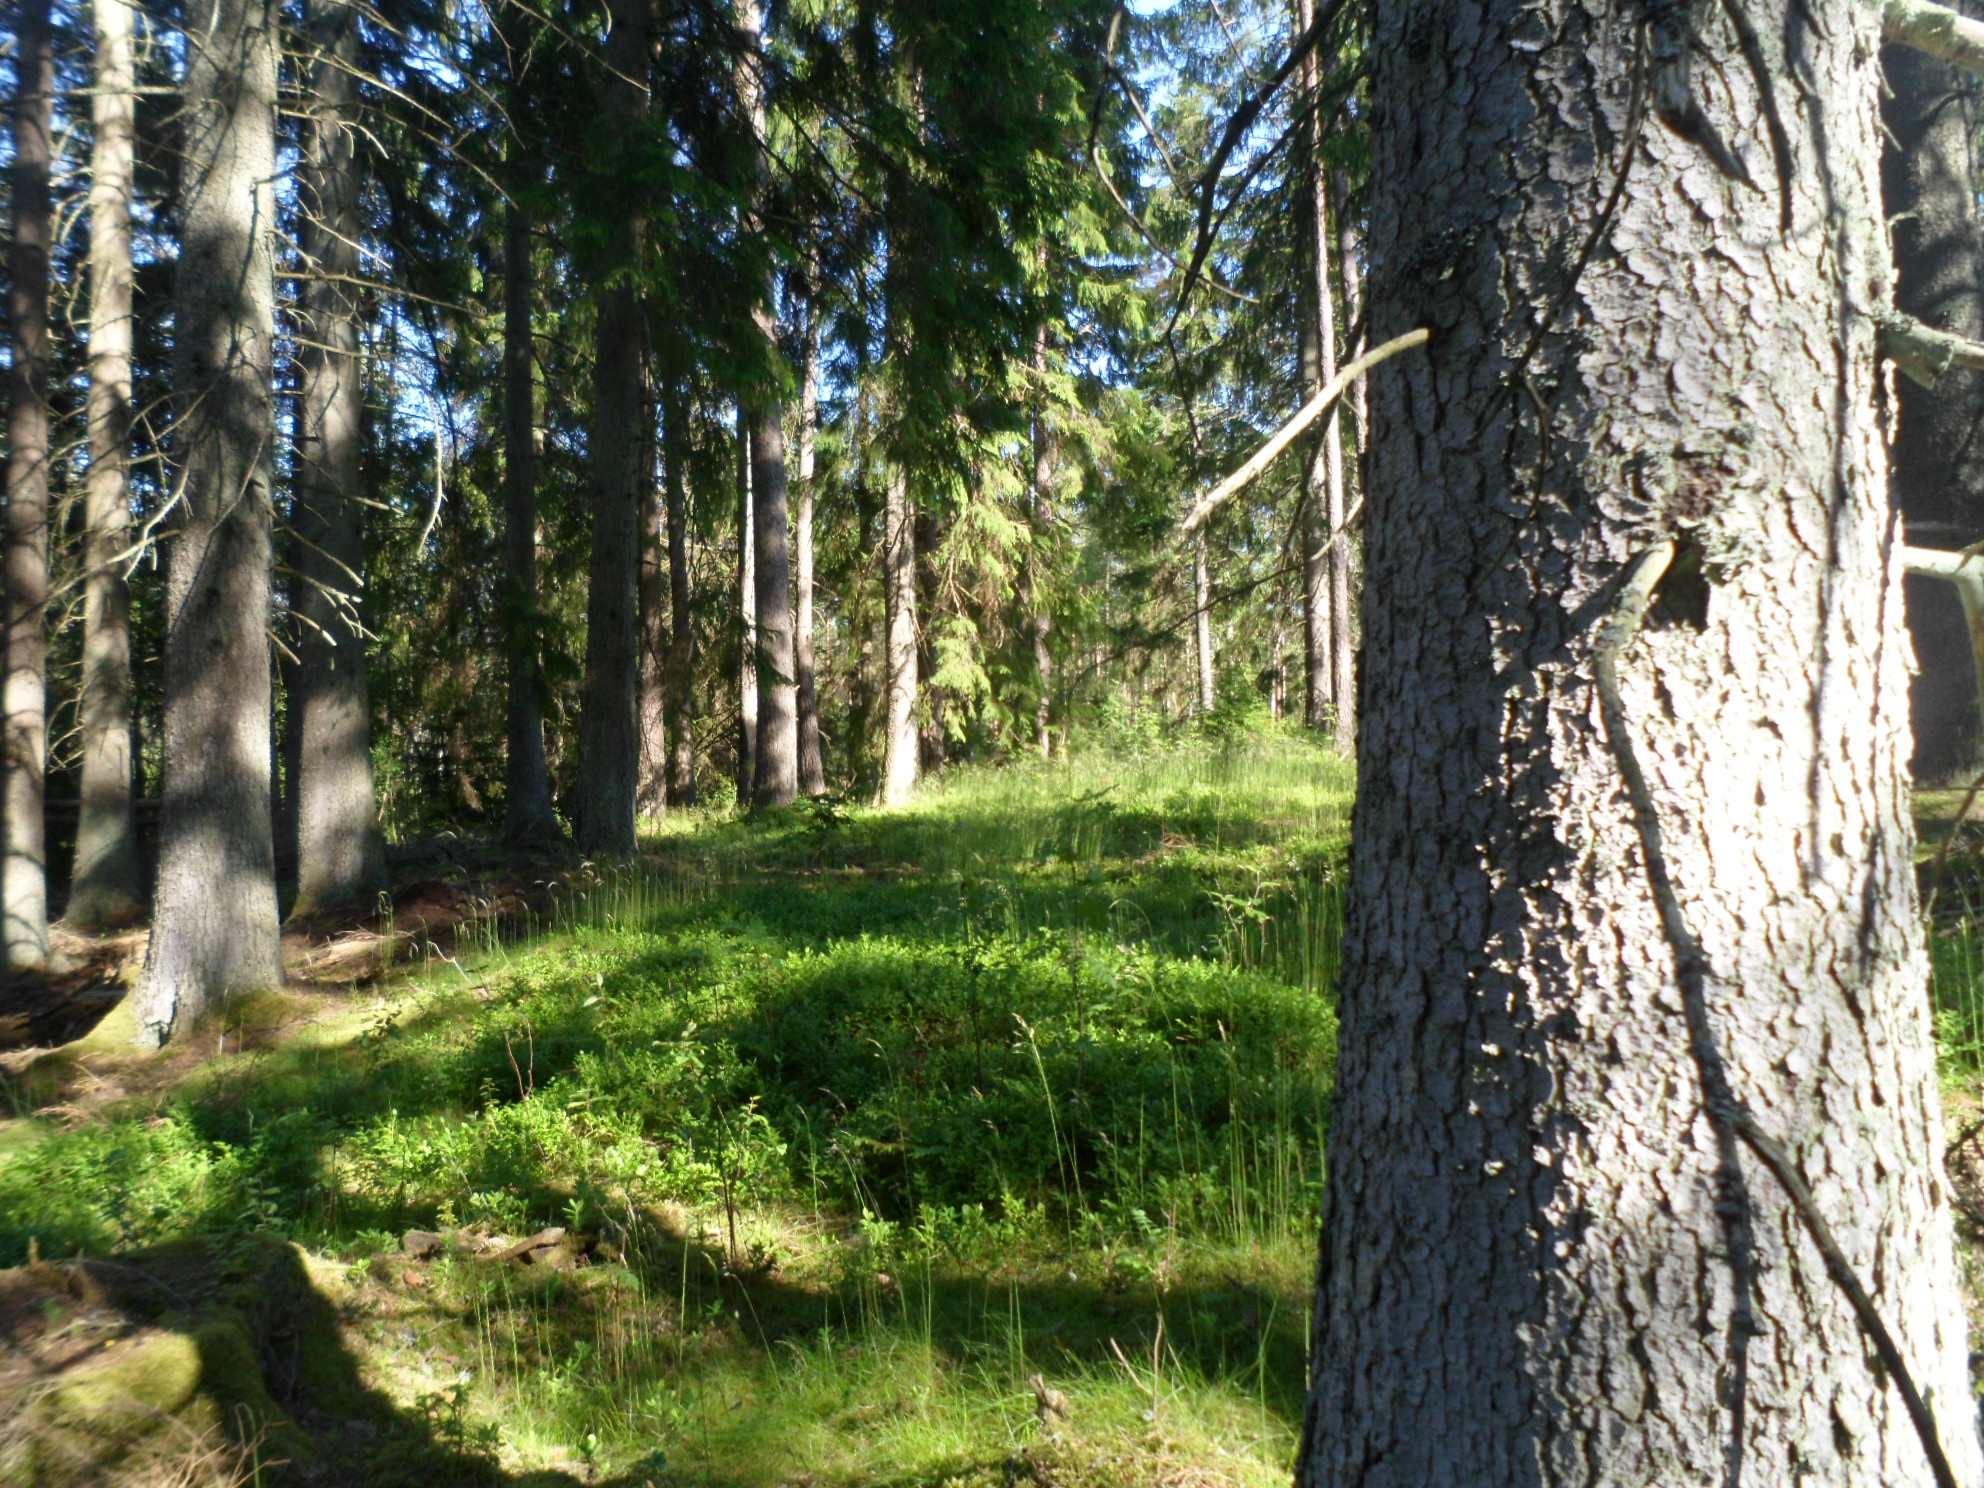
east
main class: Woodland
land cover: Spruce dominated coniferous woodland
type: boreal forest
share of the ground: 50 - 75 %
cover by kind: coniferous forest trees 55 %, shrubs 20 %, broadleaved forest trees 10 %, lichens and mosses 10 %, herbaceous plants 5 %
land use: Forestry
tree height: > 5 m
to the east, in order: Spruce dominated coniferous woodland; Pine dominated coniferous woodland; Ditches and canals; Pine dominated mixed woodland
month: July
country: SE
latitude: 57.4331
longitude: 14.7431
